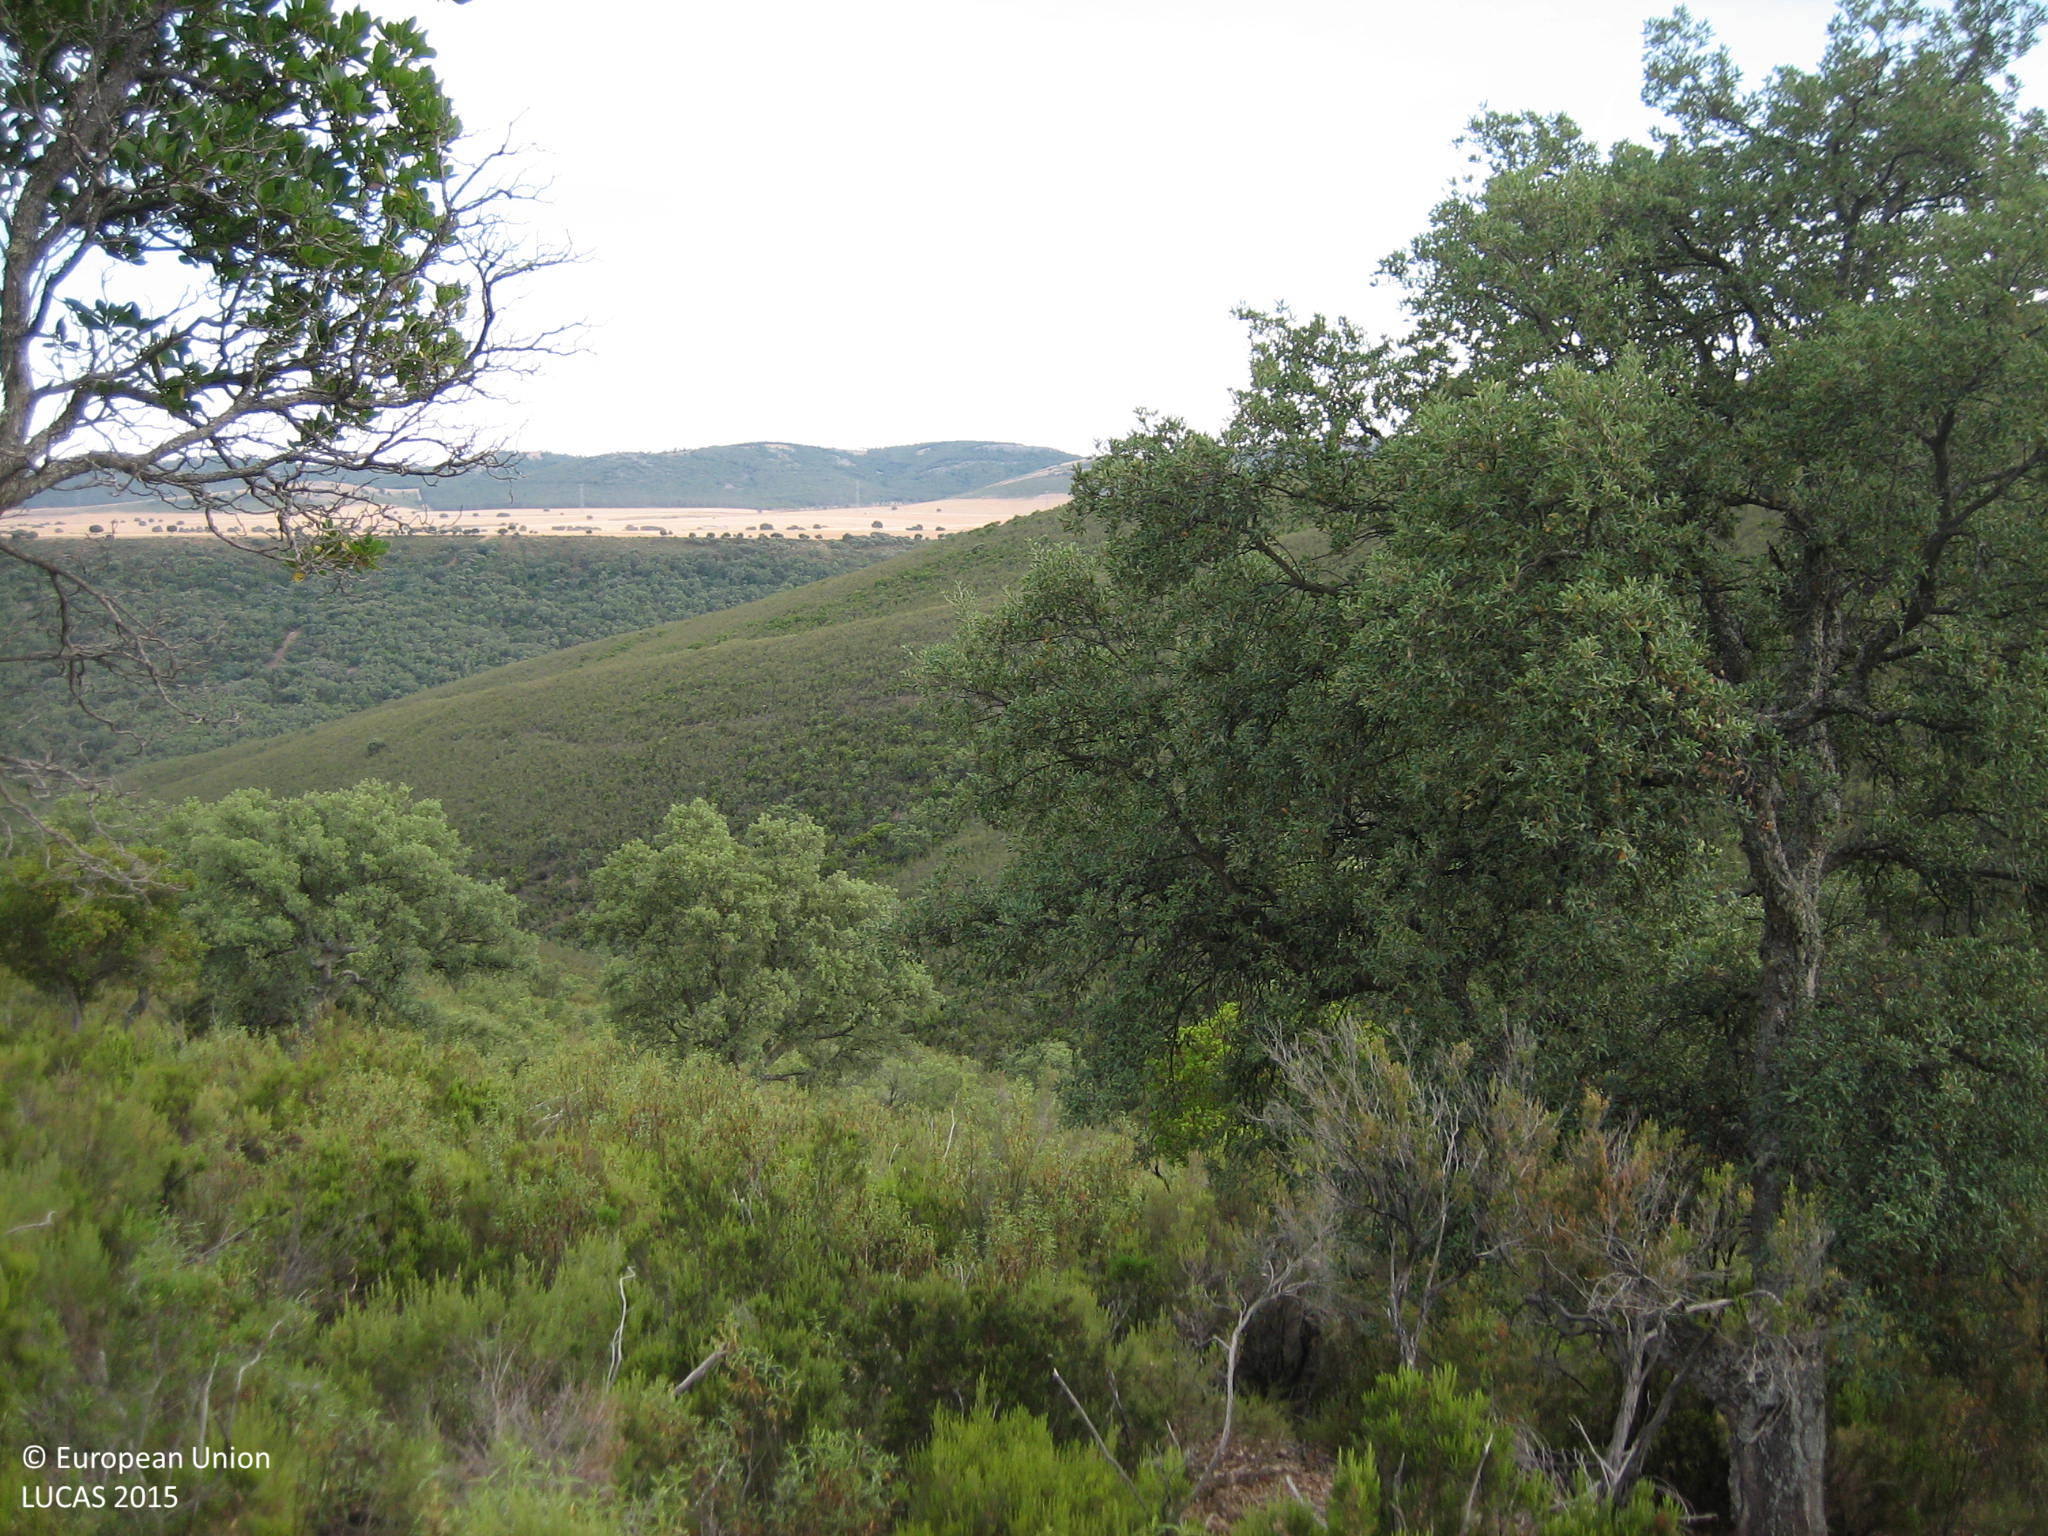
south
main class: Shrubland
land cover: Shrubland with sparse tree cover
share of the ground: > 75 %
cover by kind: shrubs 90 %, broadleaved forest trees 5 %, herbaceous plants 5 %
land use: Semi-natural and natural areas not in use
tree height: > 5 m
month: June
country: ES
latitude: 39.1294
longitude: -4.7364
